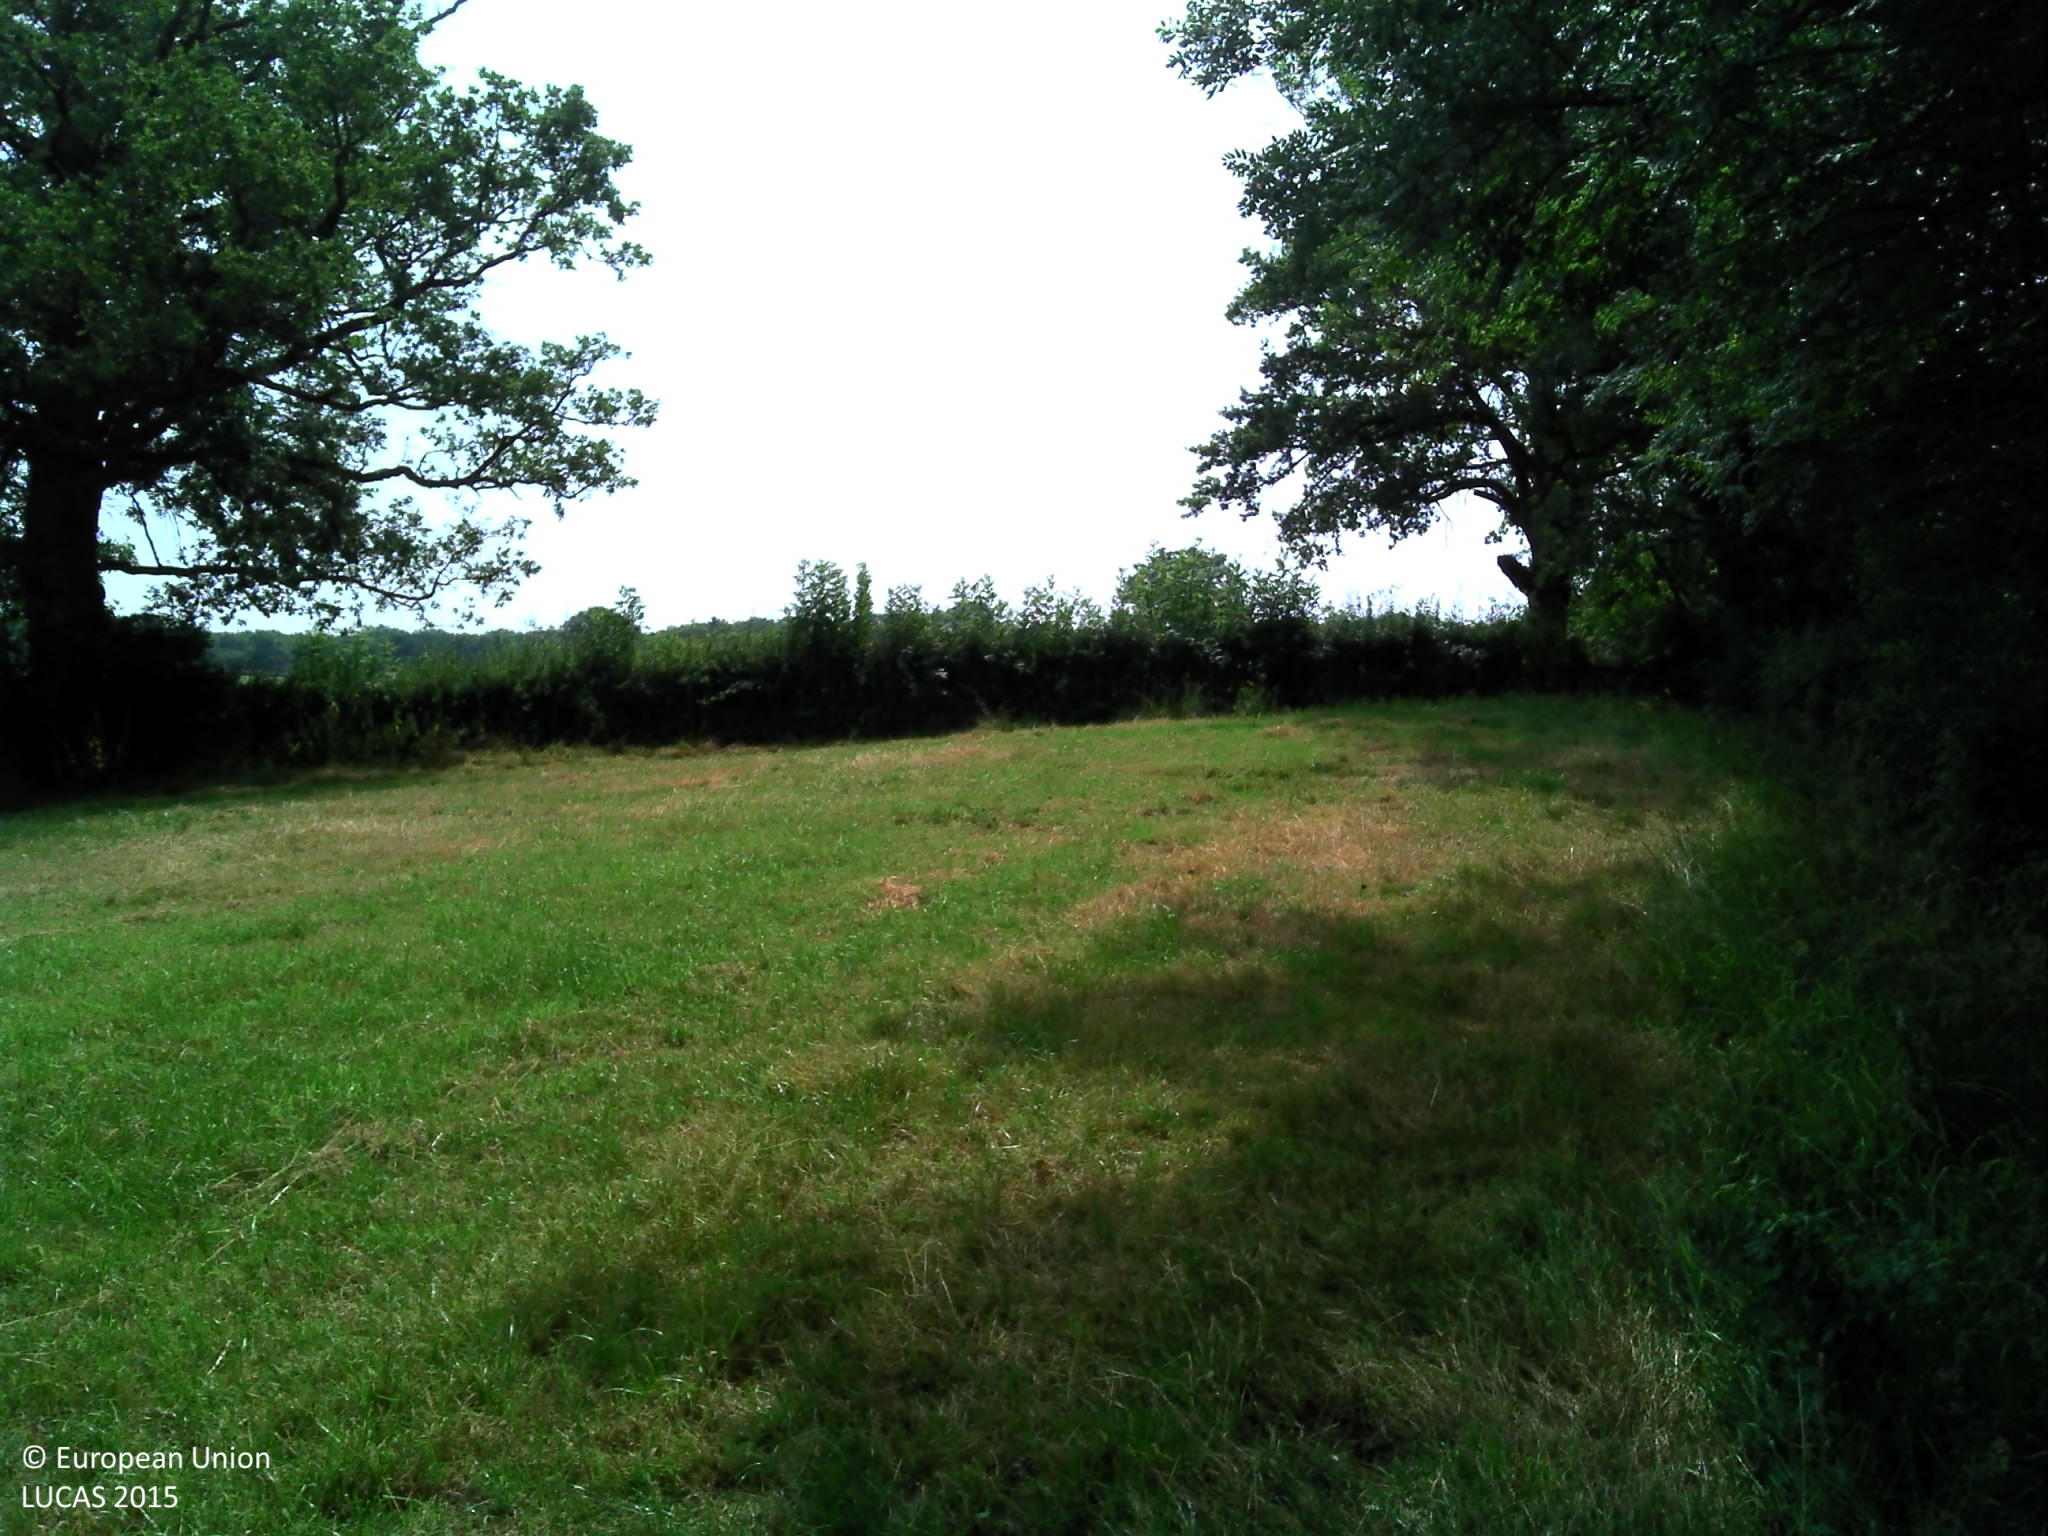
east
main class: Grassland
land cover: Grassland without tree/shrub cover
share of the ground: > 75 %
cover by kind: herbaceous plants 100 %
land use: Agriculture (excluding fallow land and kitchen gardens)
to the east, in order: Abandoned hedges; Grassland without tree/shrub cover; Fences; Managed hedges; Fences; Grassland without tree/shrub cover
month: July
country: FR
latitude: 47.1124
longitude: 3.5265
